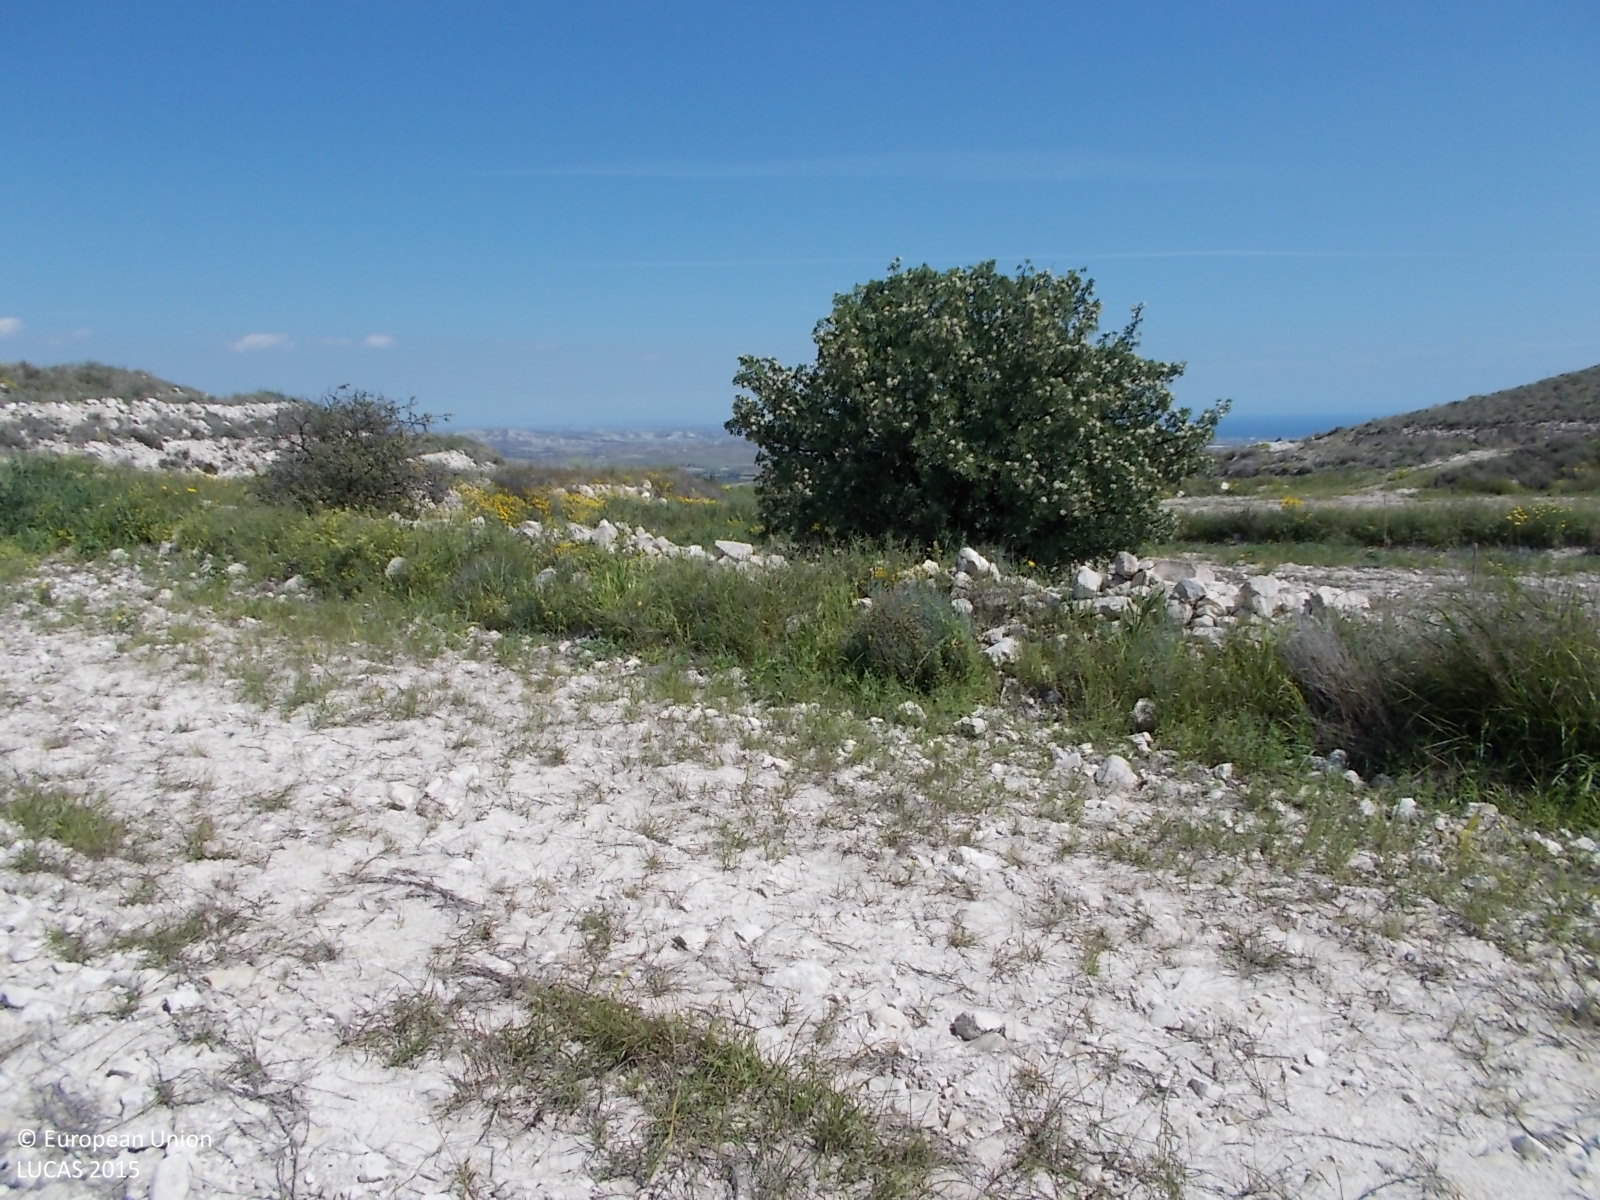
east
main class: Cropland
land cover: Olive groves
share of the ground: < 10 %
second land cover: Grassland without tree/shrub cover
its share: 25 - 50 %
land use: Agriculture (excluding fallow land and kitchen gardens)
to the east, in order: Olive groves; Grassland without tree/shrub cover; Single bushes/trees; Other bare soil; Spontaneously vegetated surfaces; Other bare soil; Grassland without tree/shrub cover; Other bare soil; Grassland with sparse tree/shrub cover; Shrubland without tree cover; Rivers and streams; Shrubland without tree cover; Spontaneously vegetated surfaces
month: April
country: CY
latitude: 35.0089
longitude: 33.5476
